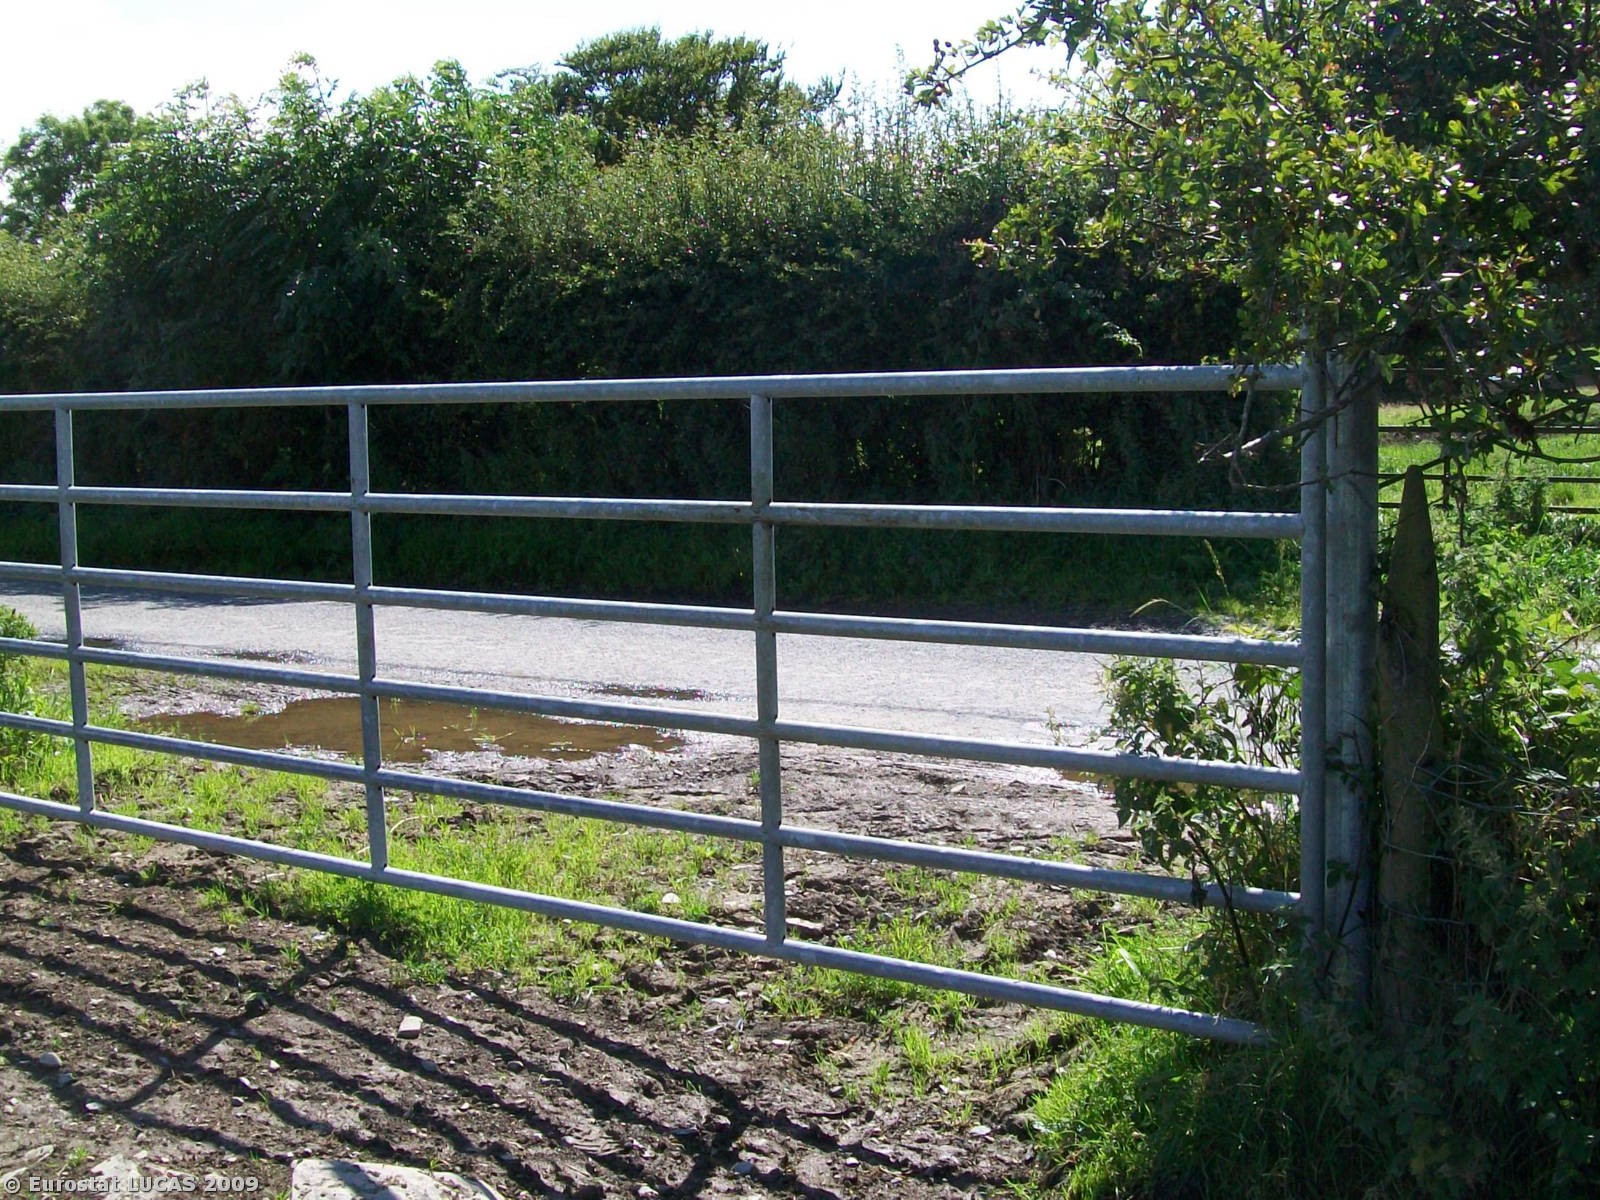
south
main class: Grassland
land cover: Grassland without tree/shrub cover
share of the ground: > 75 %
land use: Agriculture (excluding fallow land and kitchen gardens)
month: August
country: GB
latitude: 54.4425
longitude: -5.6911
